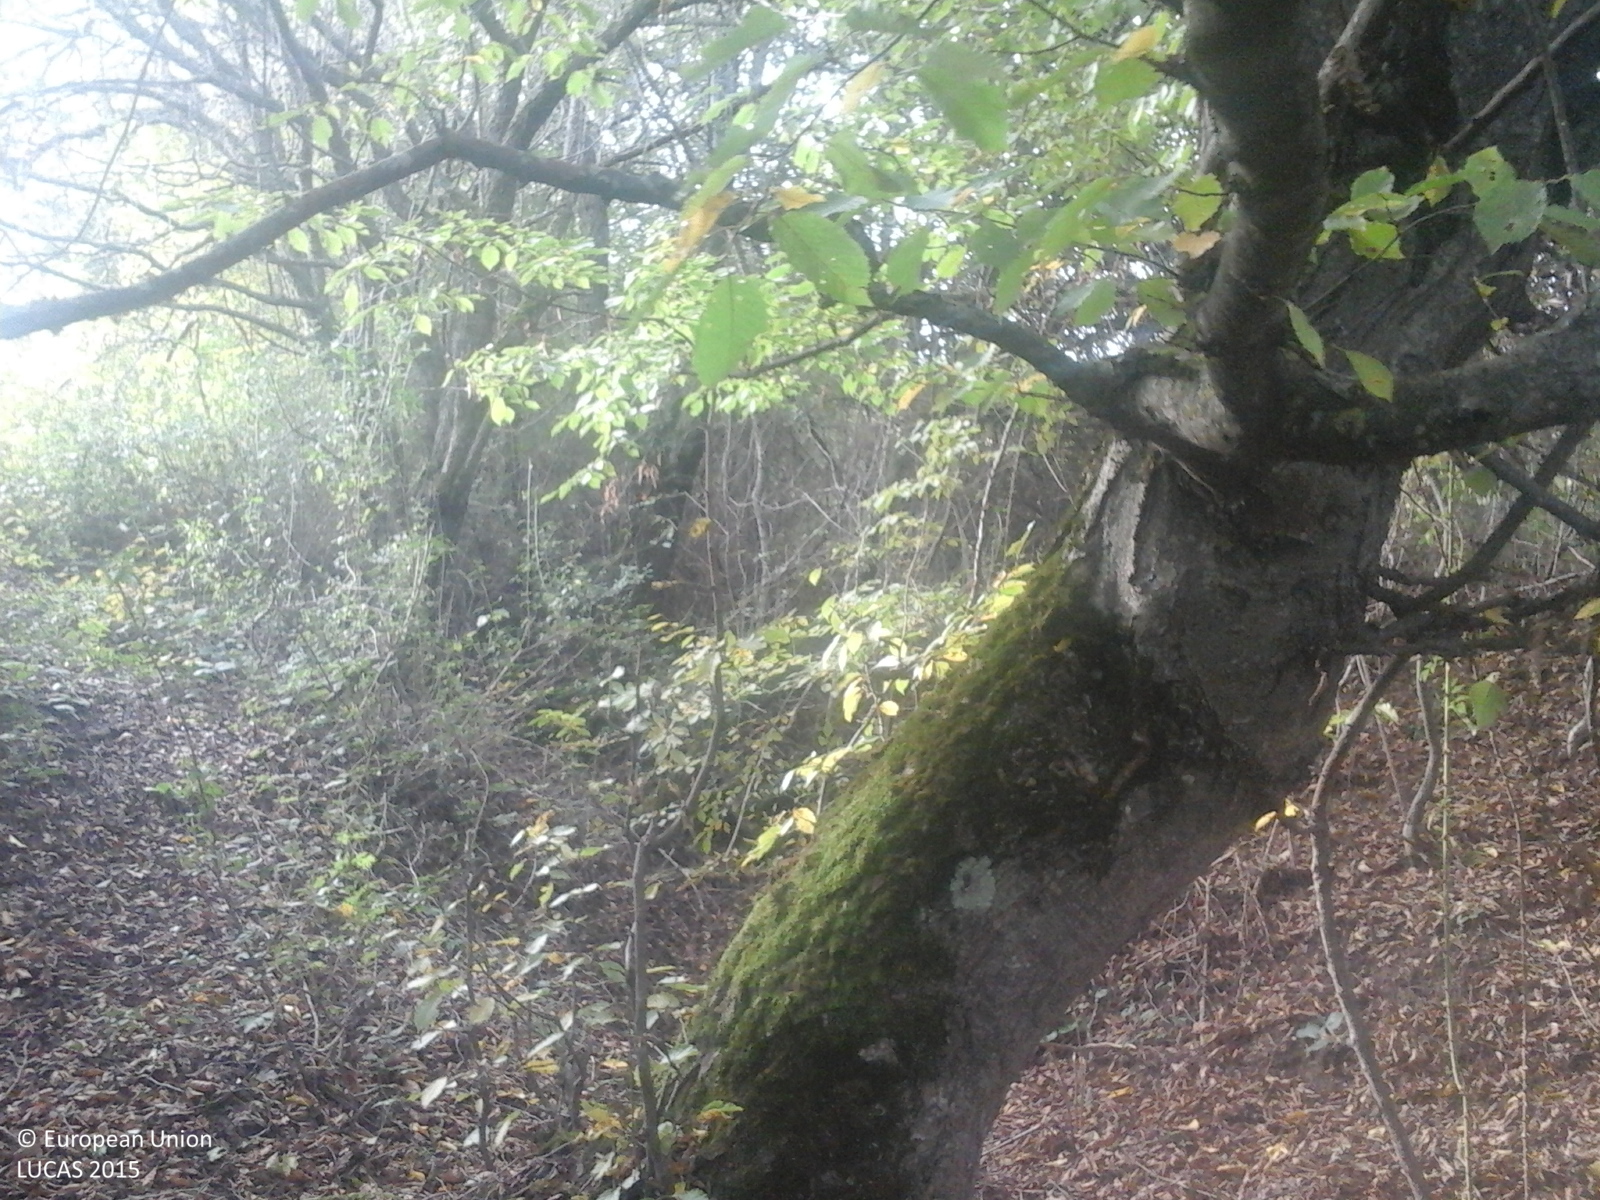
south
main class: Woodland
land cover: Broadleaved woodland
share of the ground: > 75 %
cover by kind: broadleaved forest trees 100 %
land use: Forestry
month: October
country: RO
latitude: 46.1234
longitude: 25.4134
